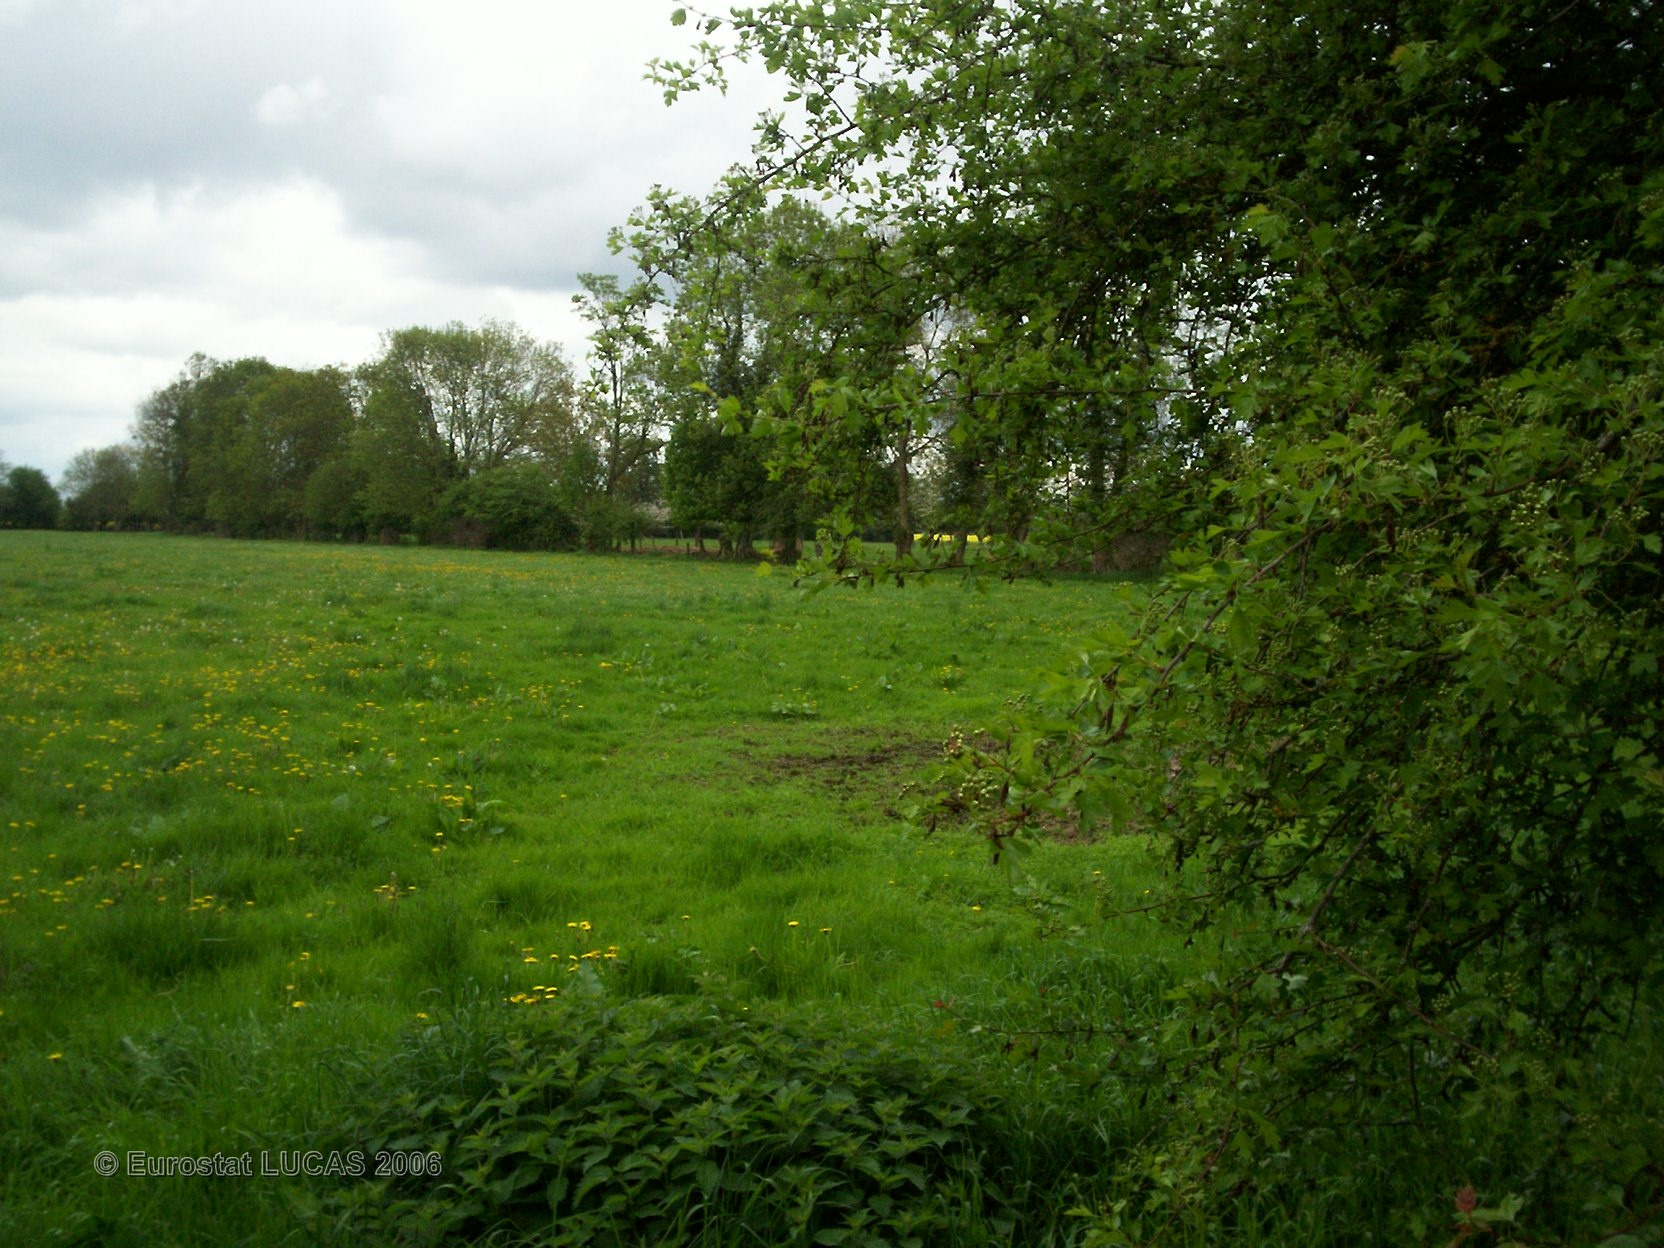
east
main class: Grassland
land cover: Grassland without tree/shrub cover
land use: Agriculture (excluding fallow land and kitchen gardens)
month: May
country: FR
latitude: 49.1172
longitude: 0.5065
